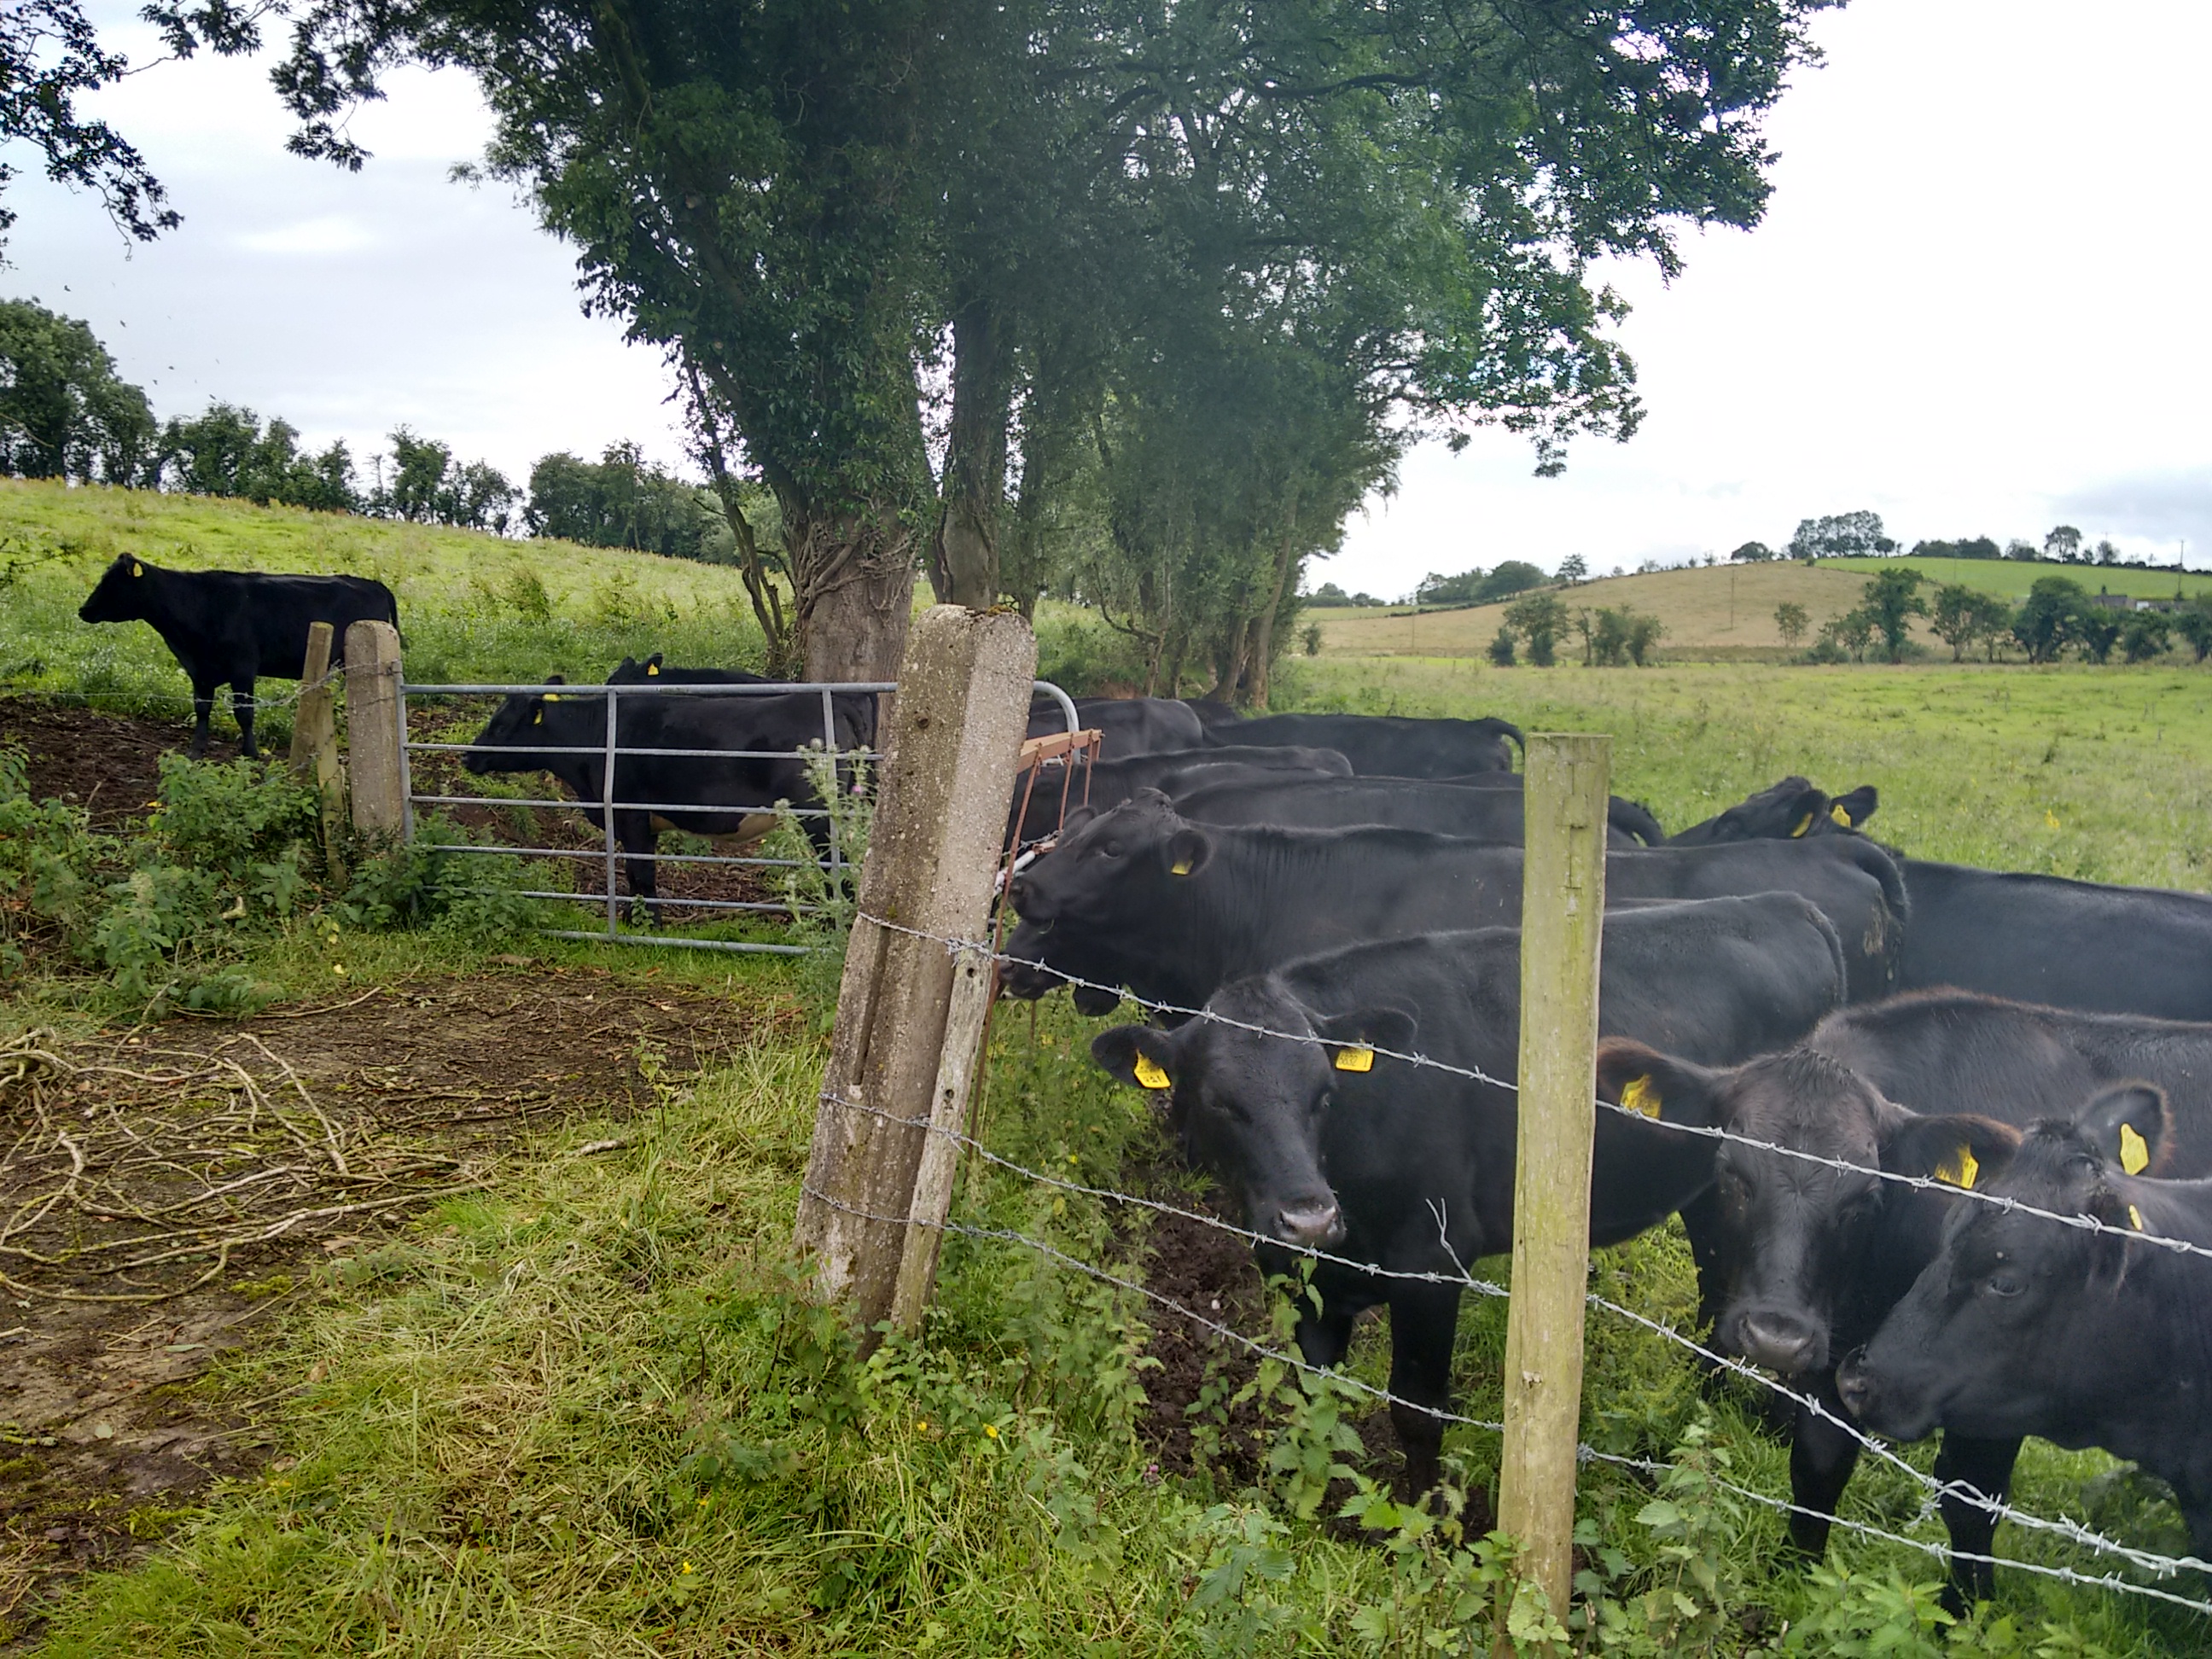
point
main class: Grassland
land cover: Grassland without tree/shrub cover
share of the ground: > 75 %
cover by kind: herbaceous plants 100 %
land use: Agriculture (excluding fallow land and kitchen gardens)
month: July
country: GB
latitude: 54.4005
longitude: -7.3576
